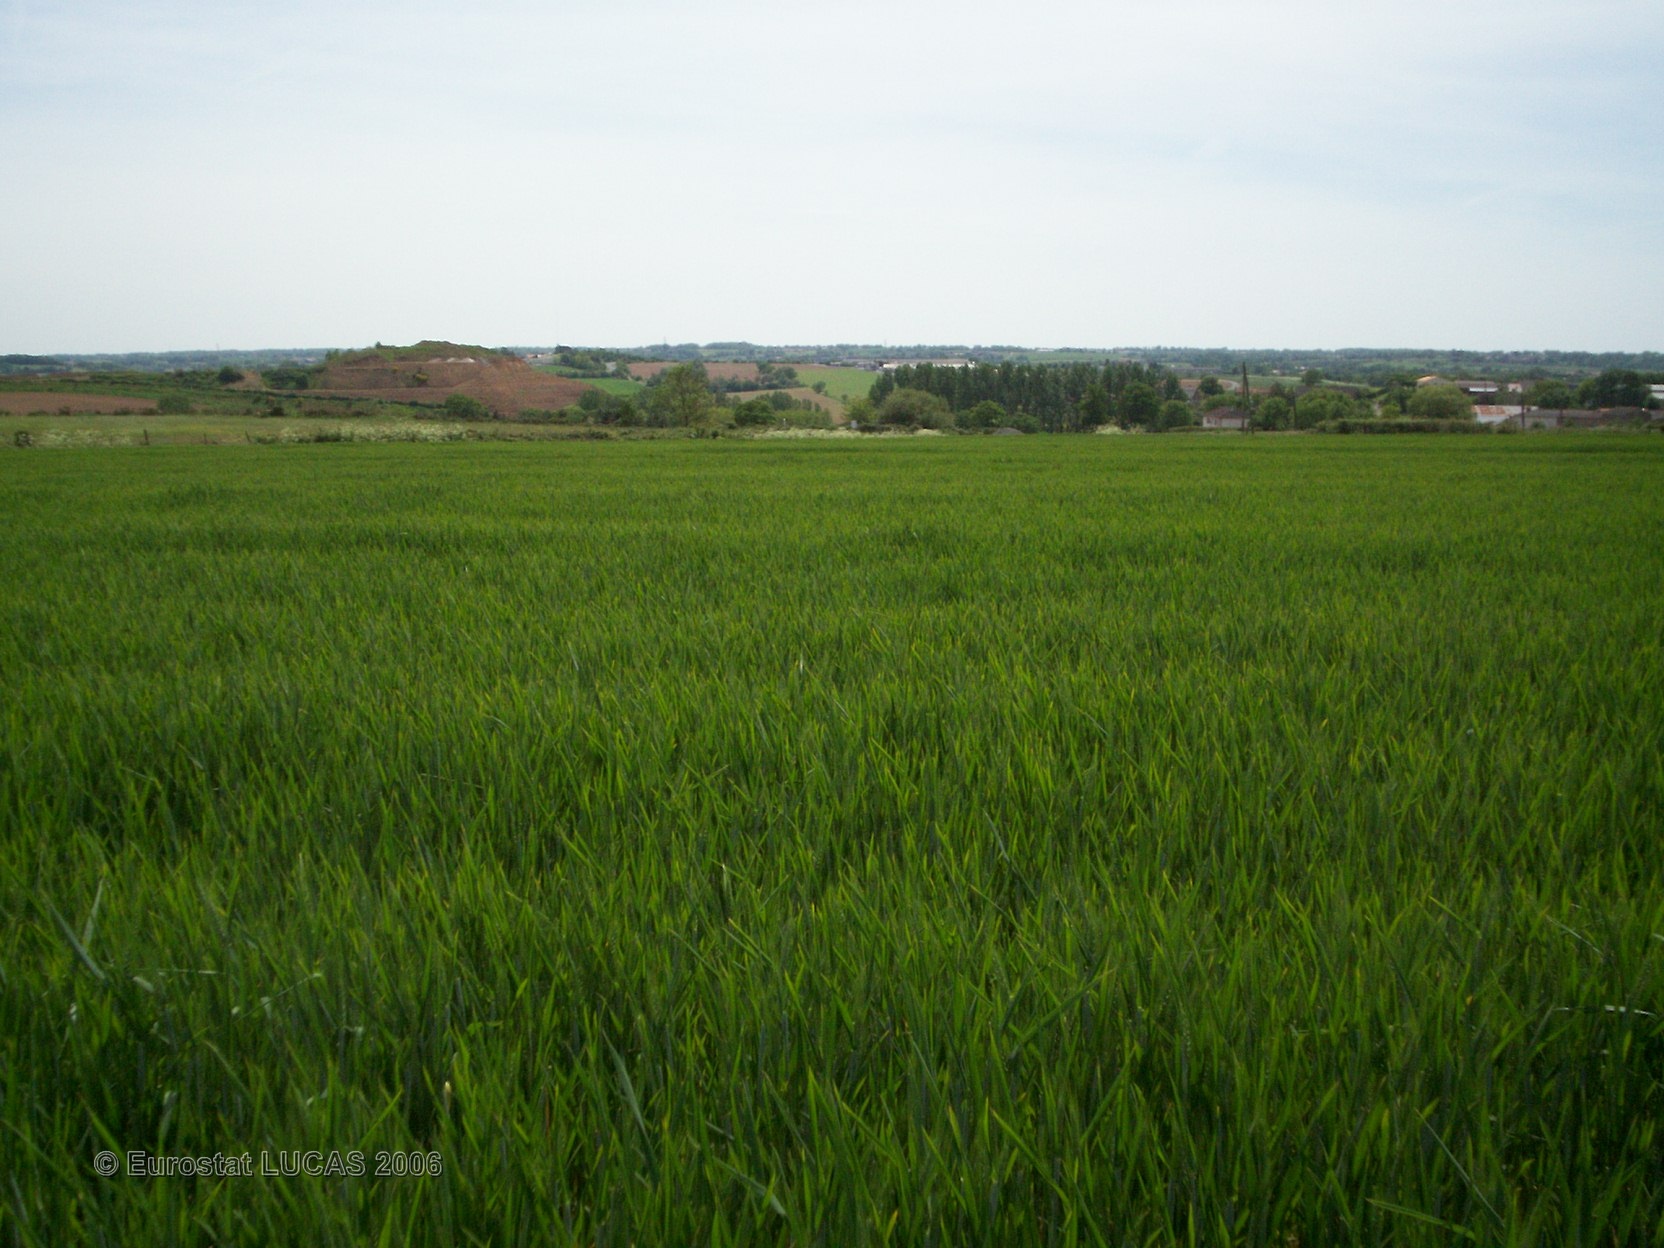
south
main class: Cropland
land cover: Common wheat
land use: Agriculture (excluding fallow land and kitchen gardens)
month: May
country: FR
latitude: 47.1044
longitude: -1.0379
